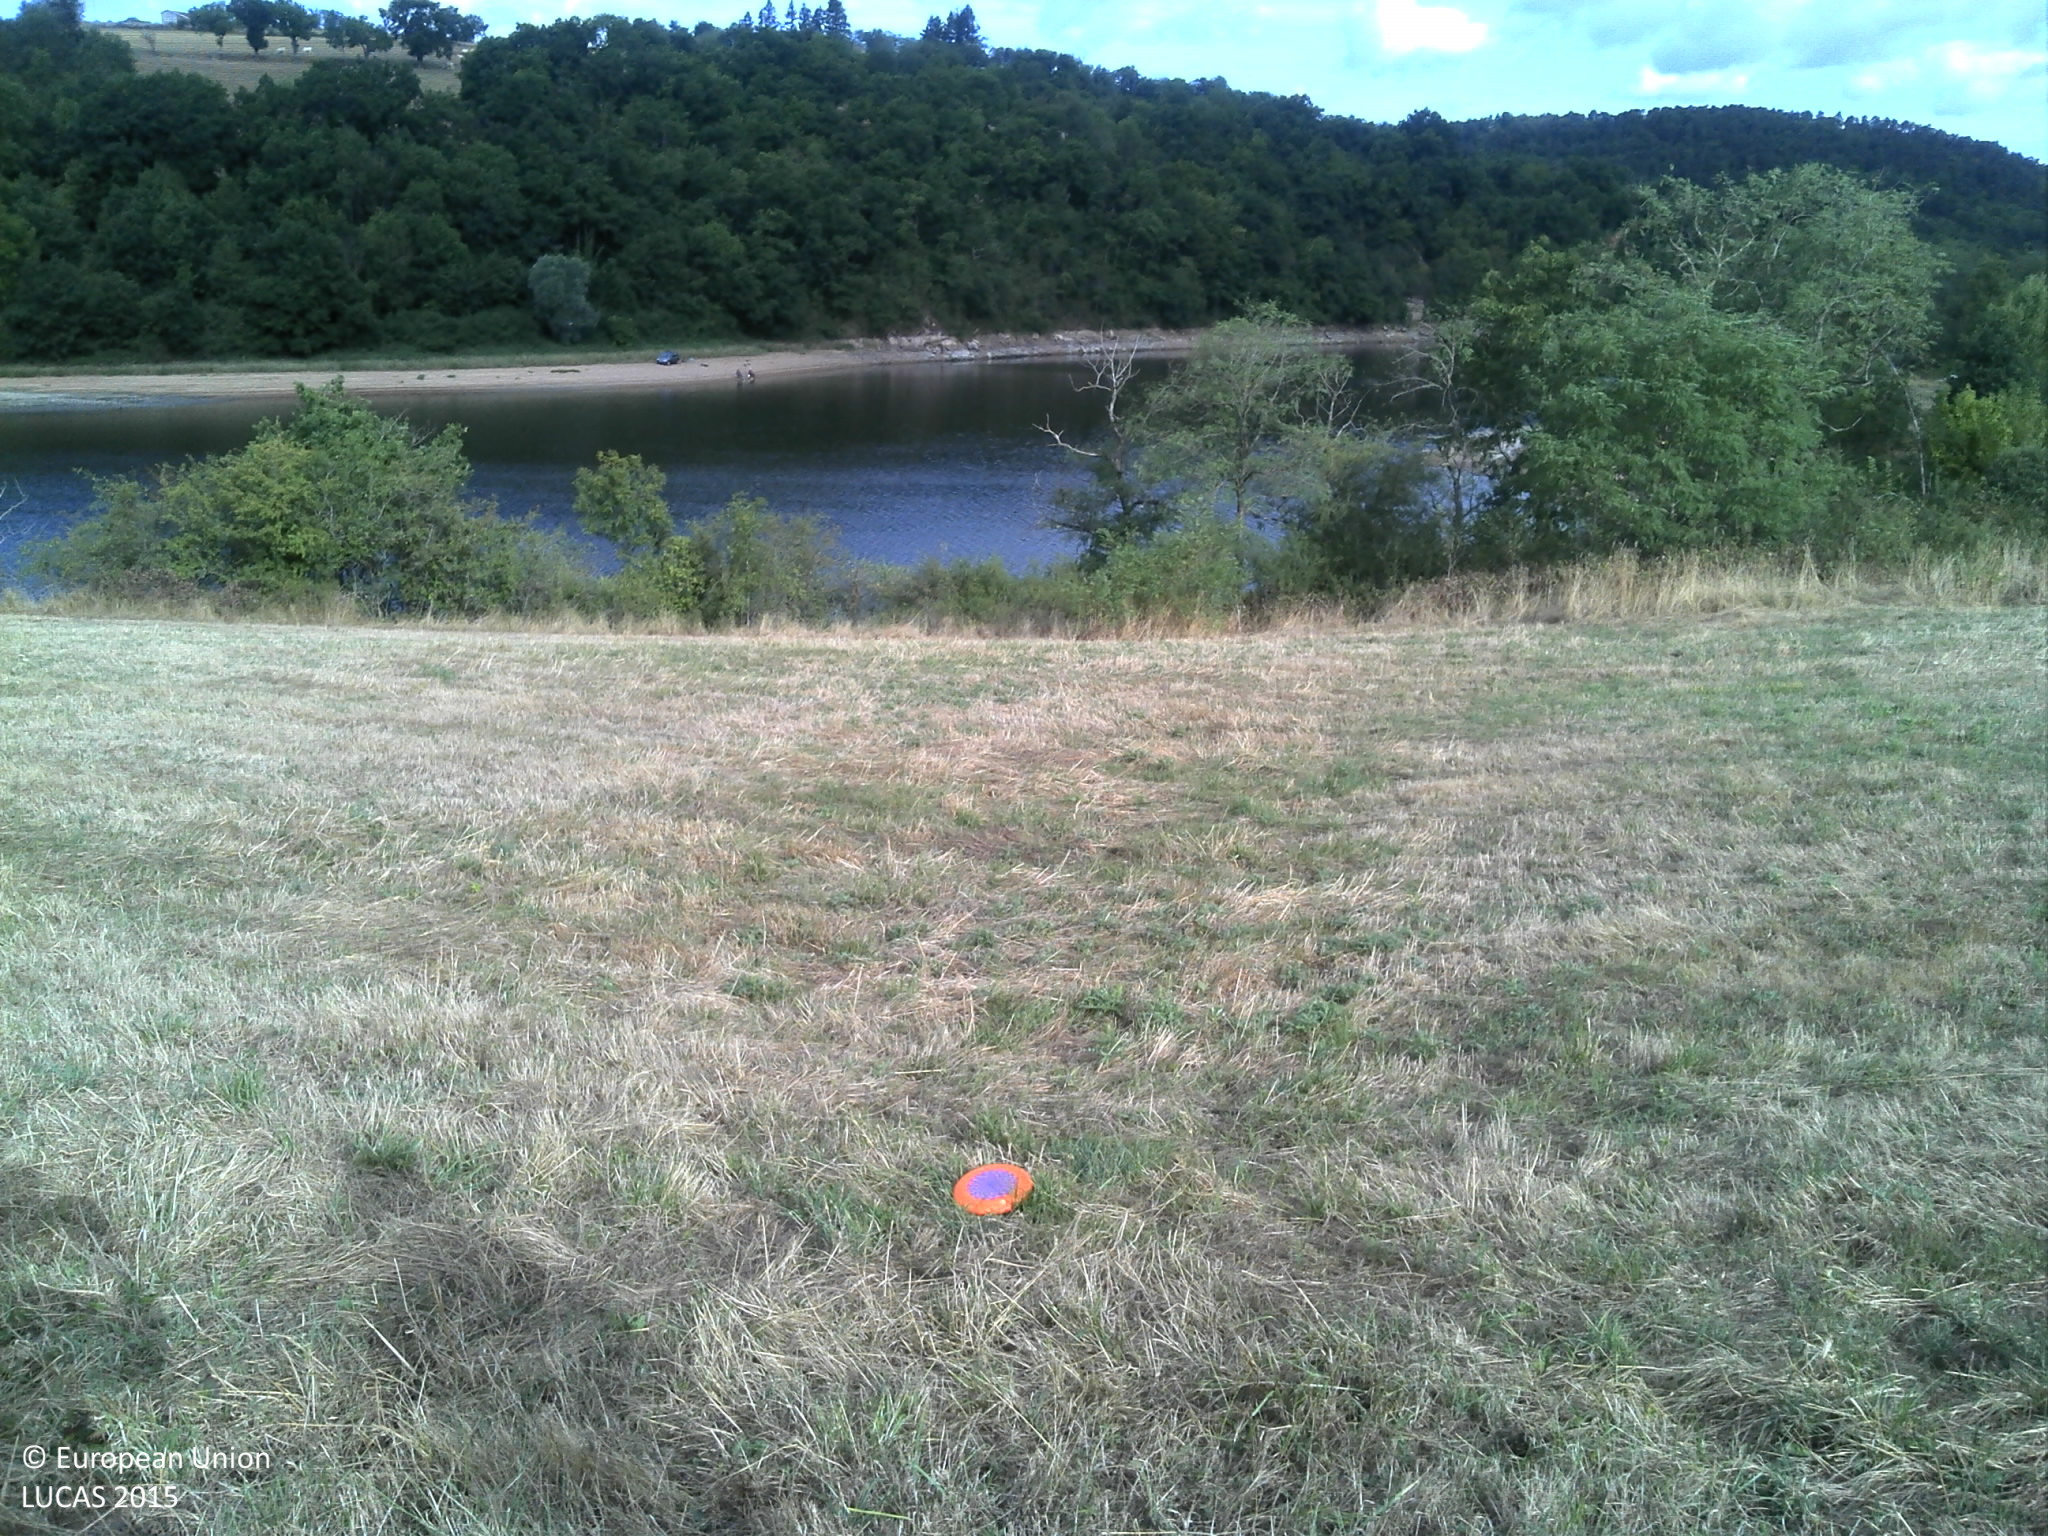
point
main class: Grassland
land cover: Grassland without tree/shrub cover
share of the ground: > 75 %
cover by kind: herbaceous plants 100 %
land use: Agriculture (excluding fallow land and kitchen gardens)
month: July
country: FR
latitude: 45.8821
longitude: 4.1136
